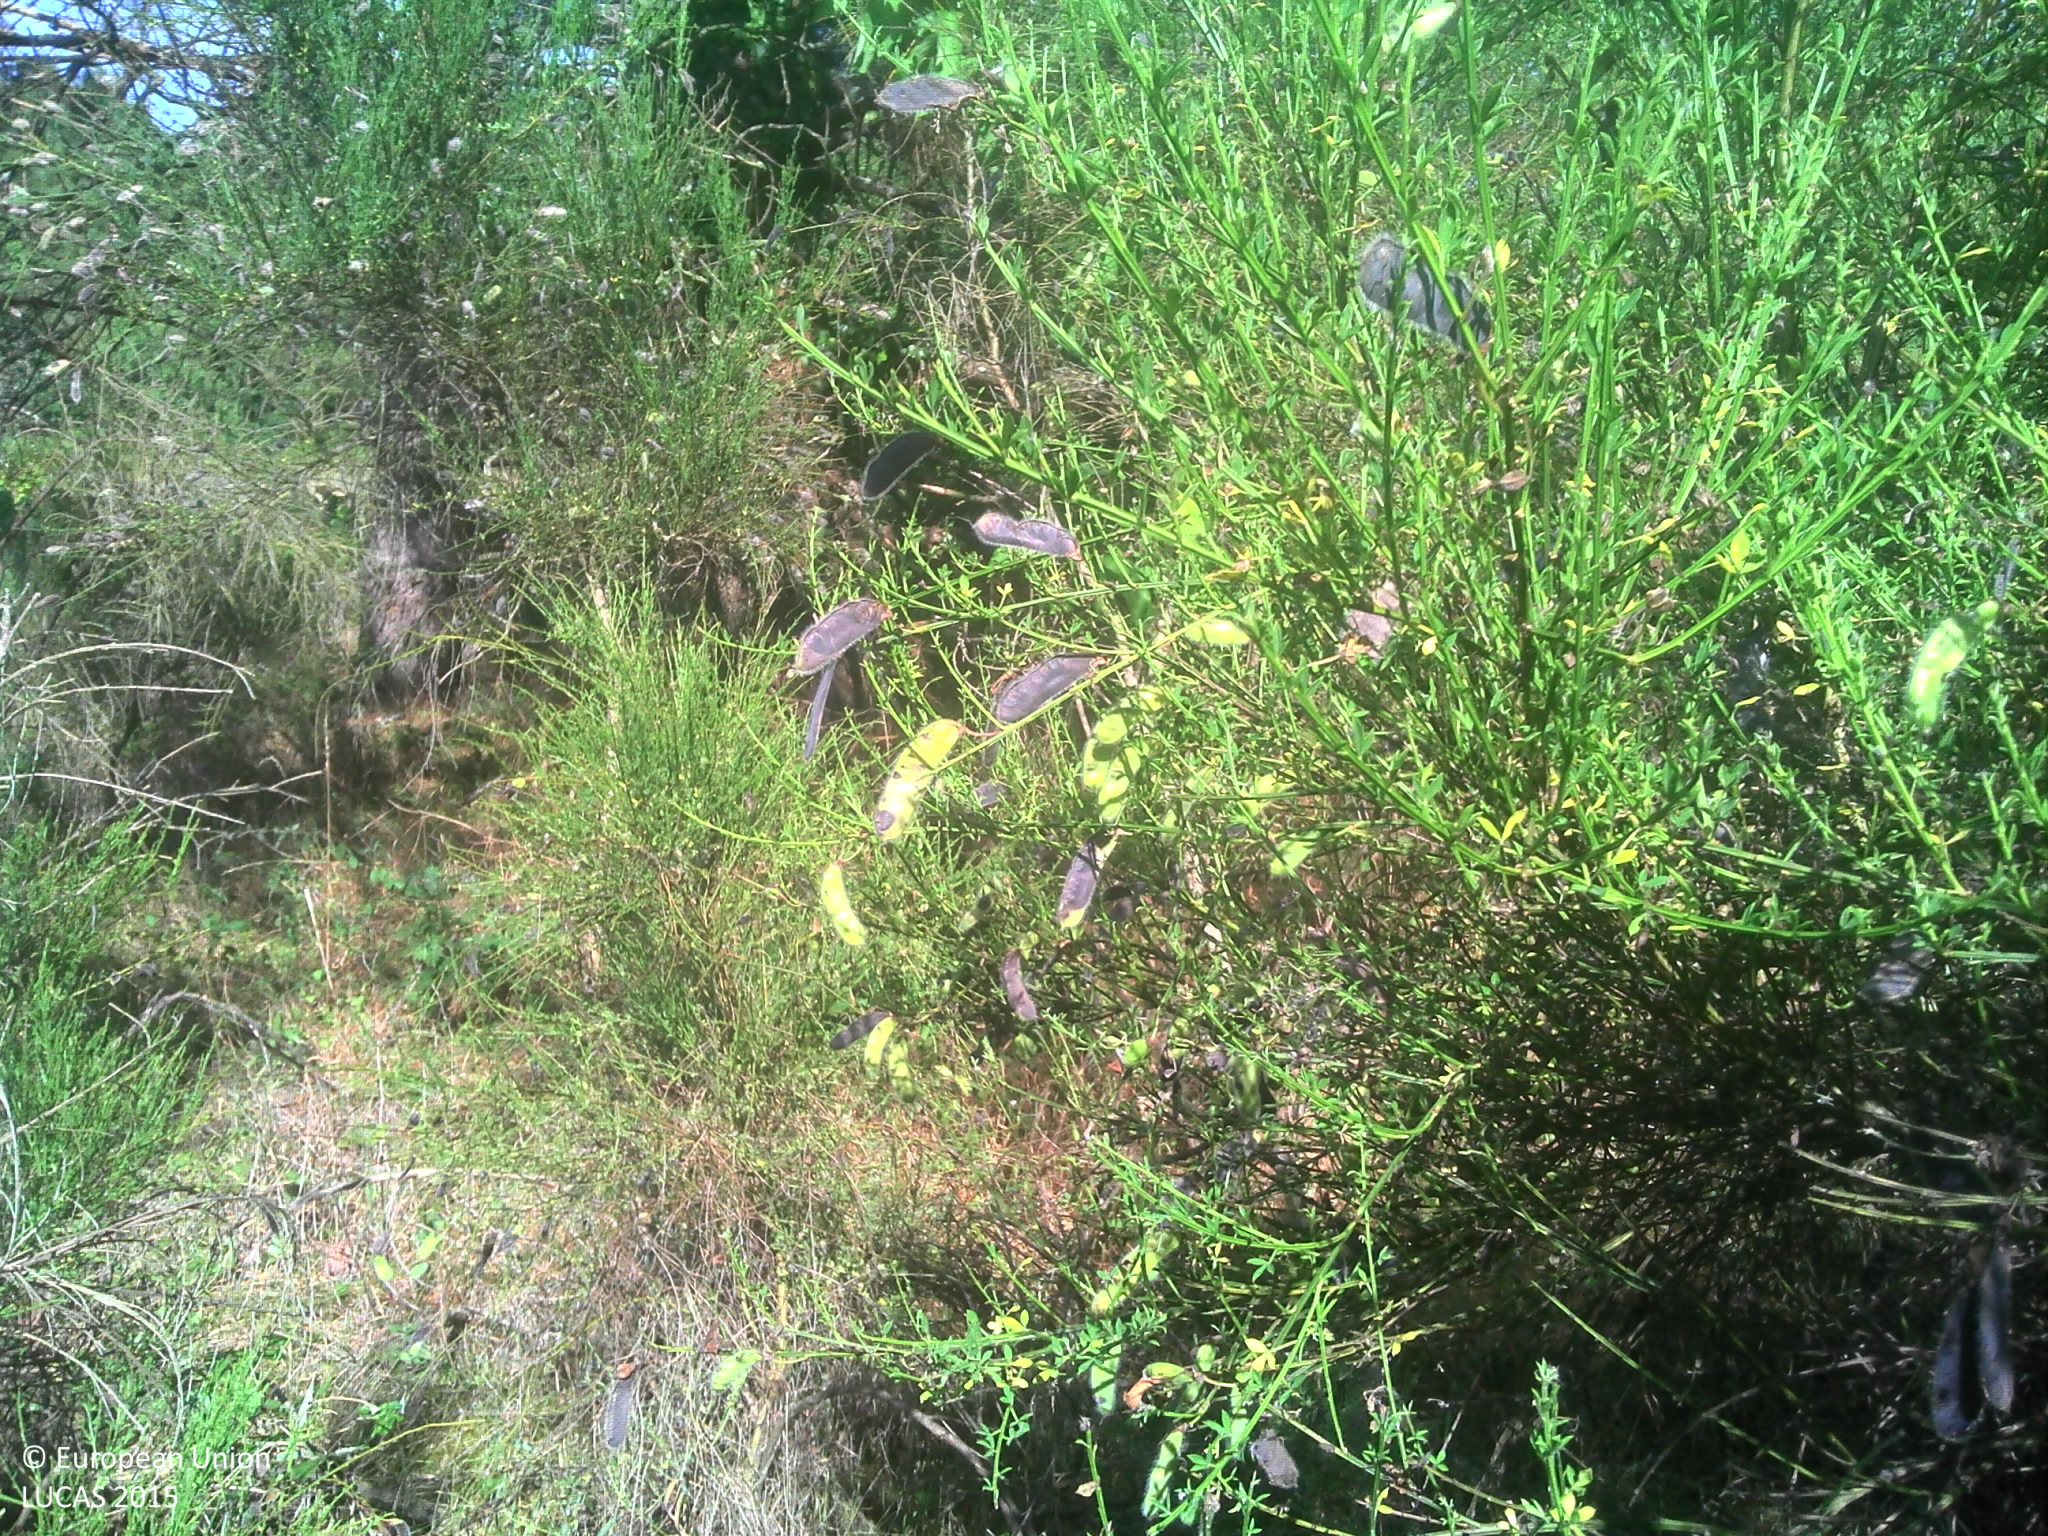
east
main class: Woodland
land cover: Pine dominated coniferous woodland
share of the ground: > 75 %
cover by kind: coniferous forest trees 50 %, lichens and mosses 20 %, unconsolidated bare surface 20 %, herbaceous plants 10 %
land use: Forestry
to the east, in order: Pine dominated coniferous woodland; Grassland without tree/shrub cover; Vineyards; Electric lines; Grassland without tree/shrub cover; Broadleaved woodland; Grassland without tree/shrub cover; Tracks; Pine dominated coniferous woodland; Broadleaved woodland; Fences; Pine dominated coniferous woodland
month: June
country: FR
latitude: 47.2806
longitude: 1.5127
